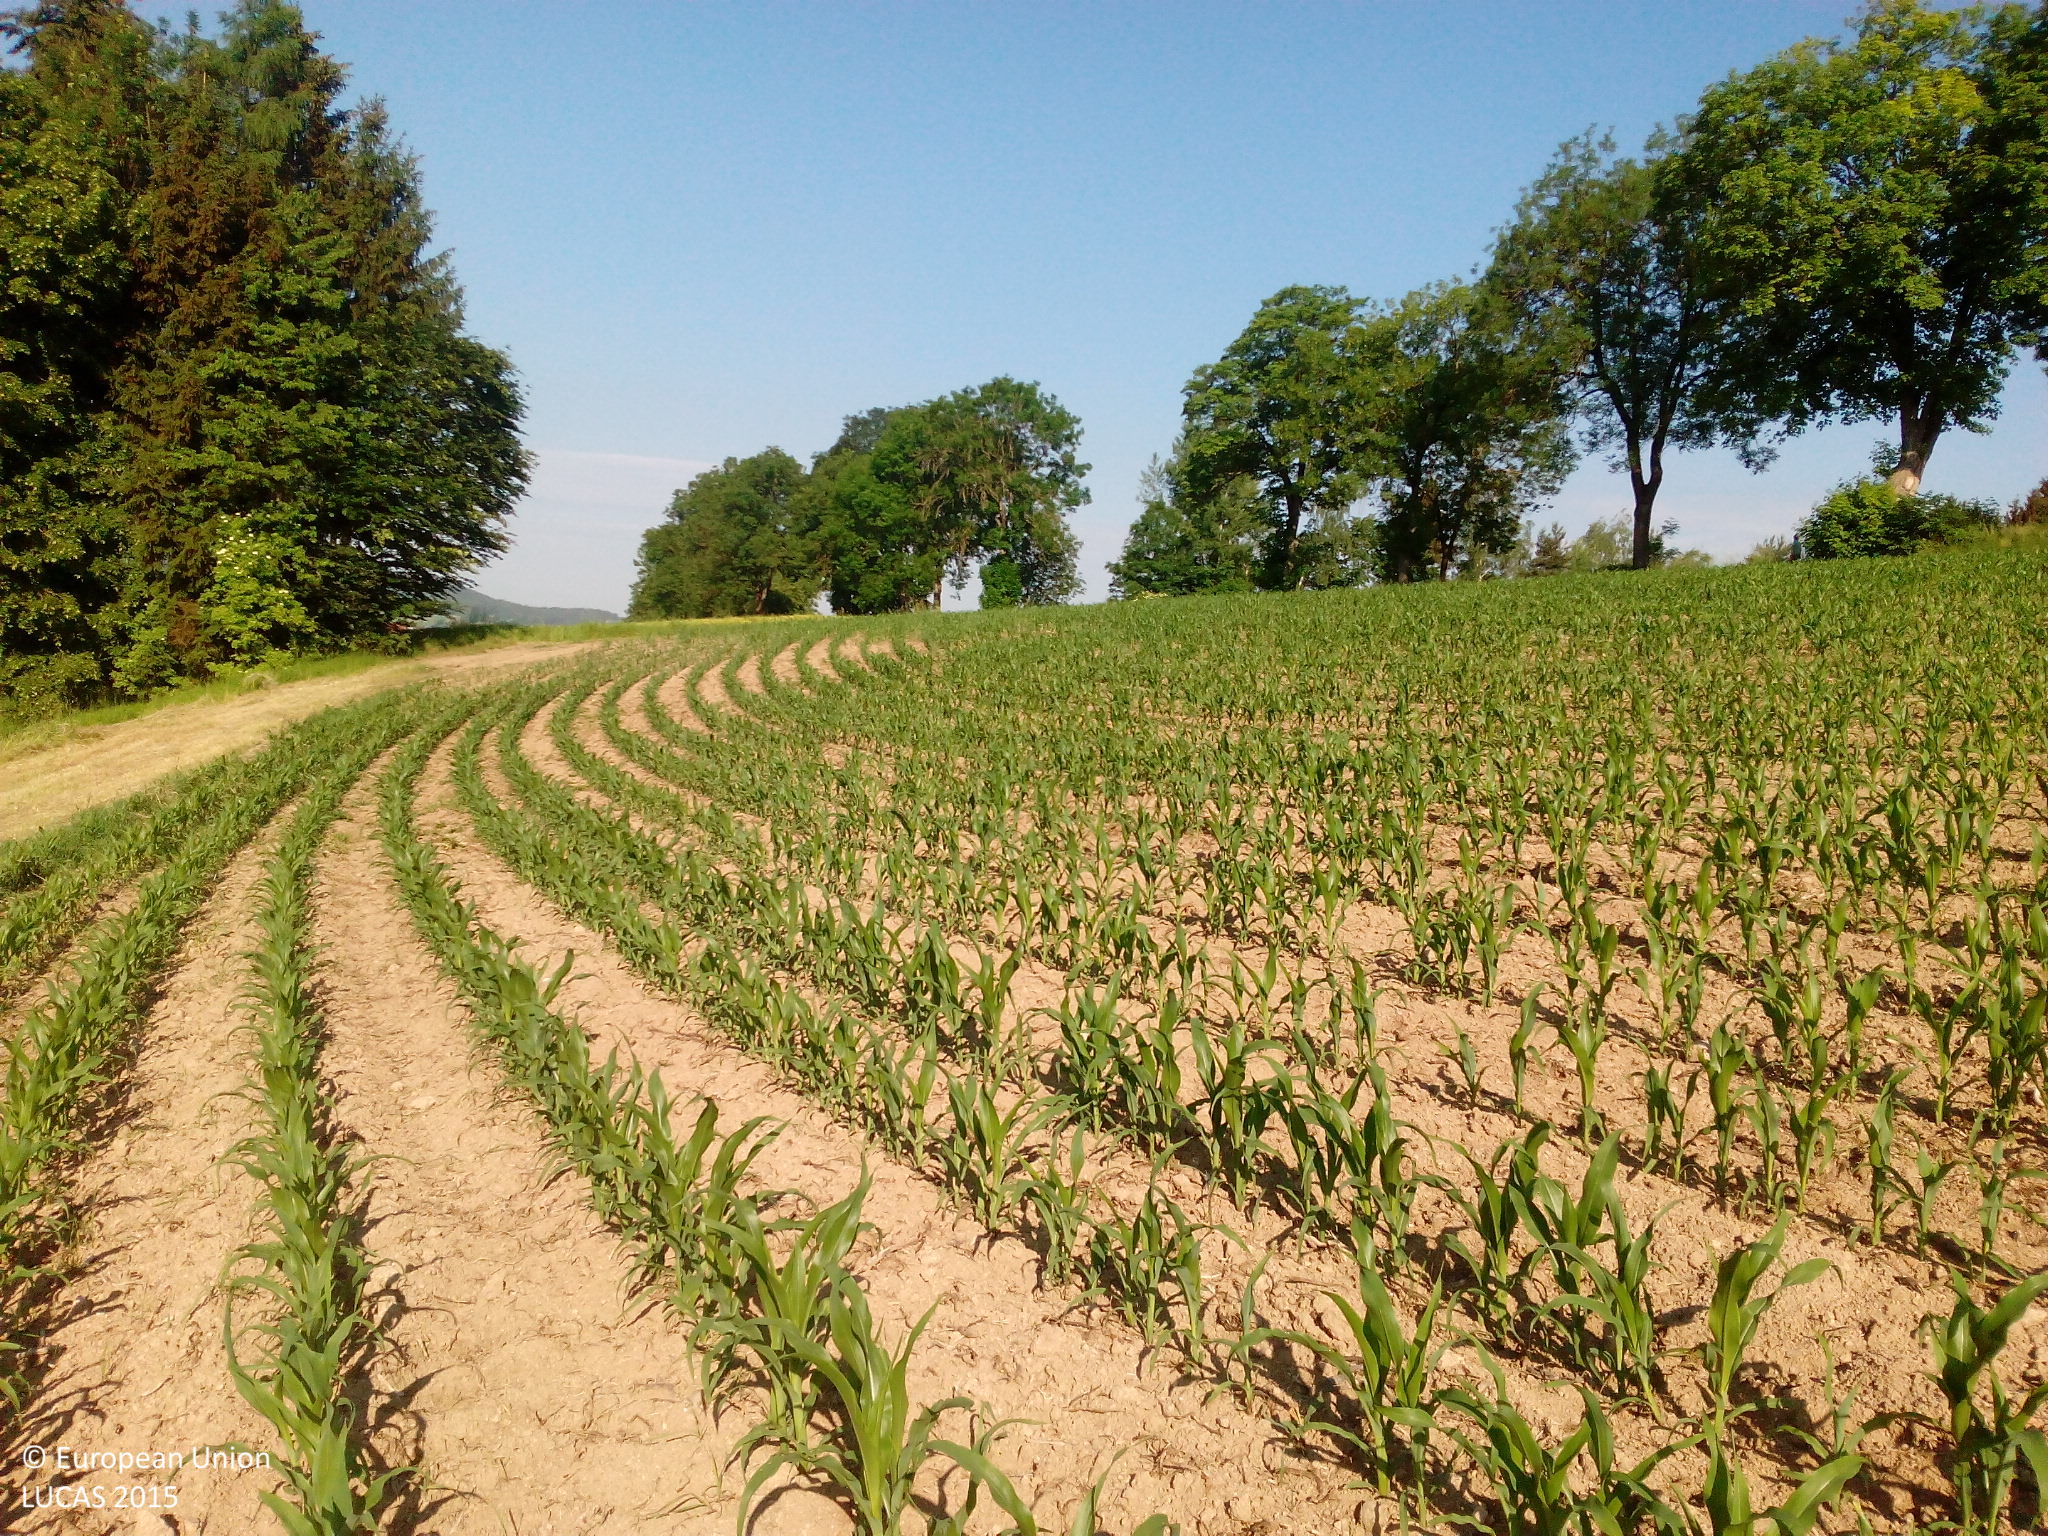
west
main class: Cropland
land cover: Maize
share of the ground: 25 - 50 %
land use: Agriculture (excluding fallow land and kitchen gardens)
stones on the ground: < 10 %
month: June
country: DE
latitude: 49.3492
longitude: 12.4085
